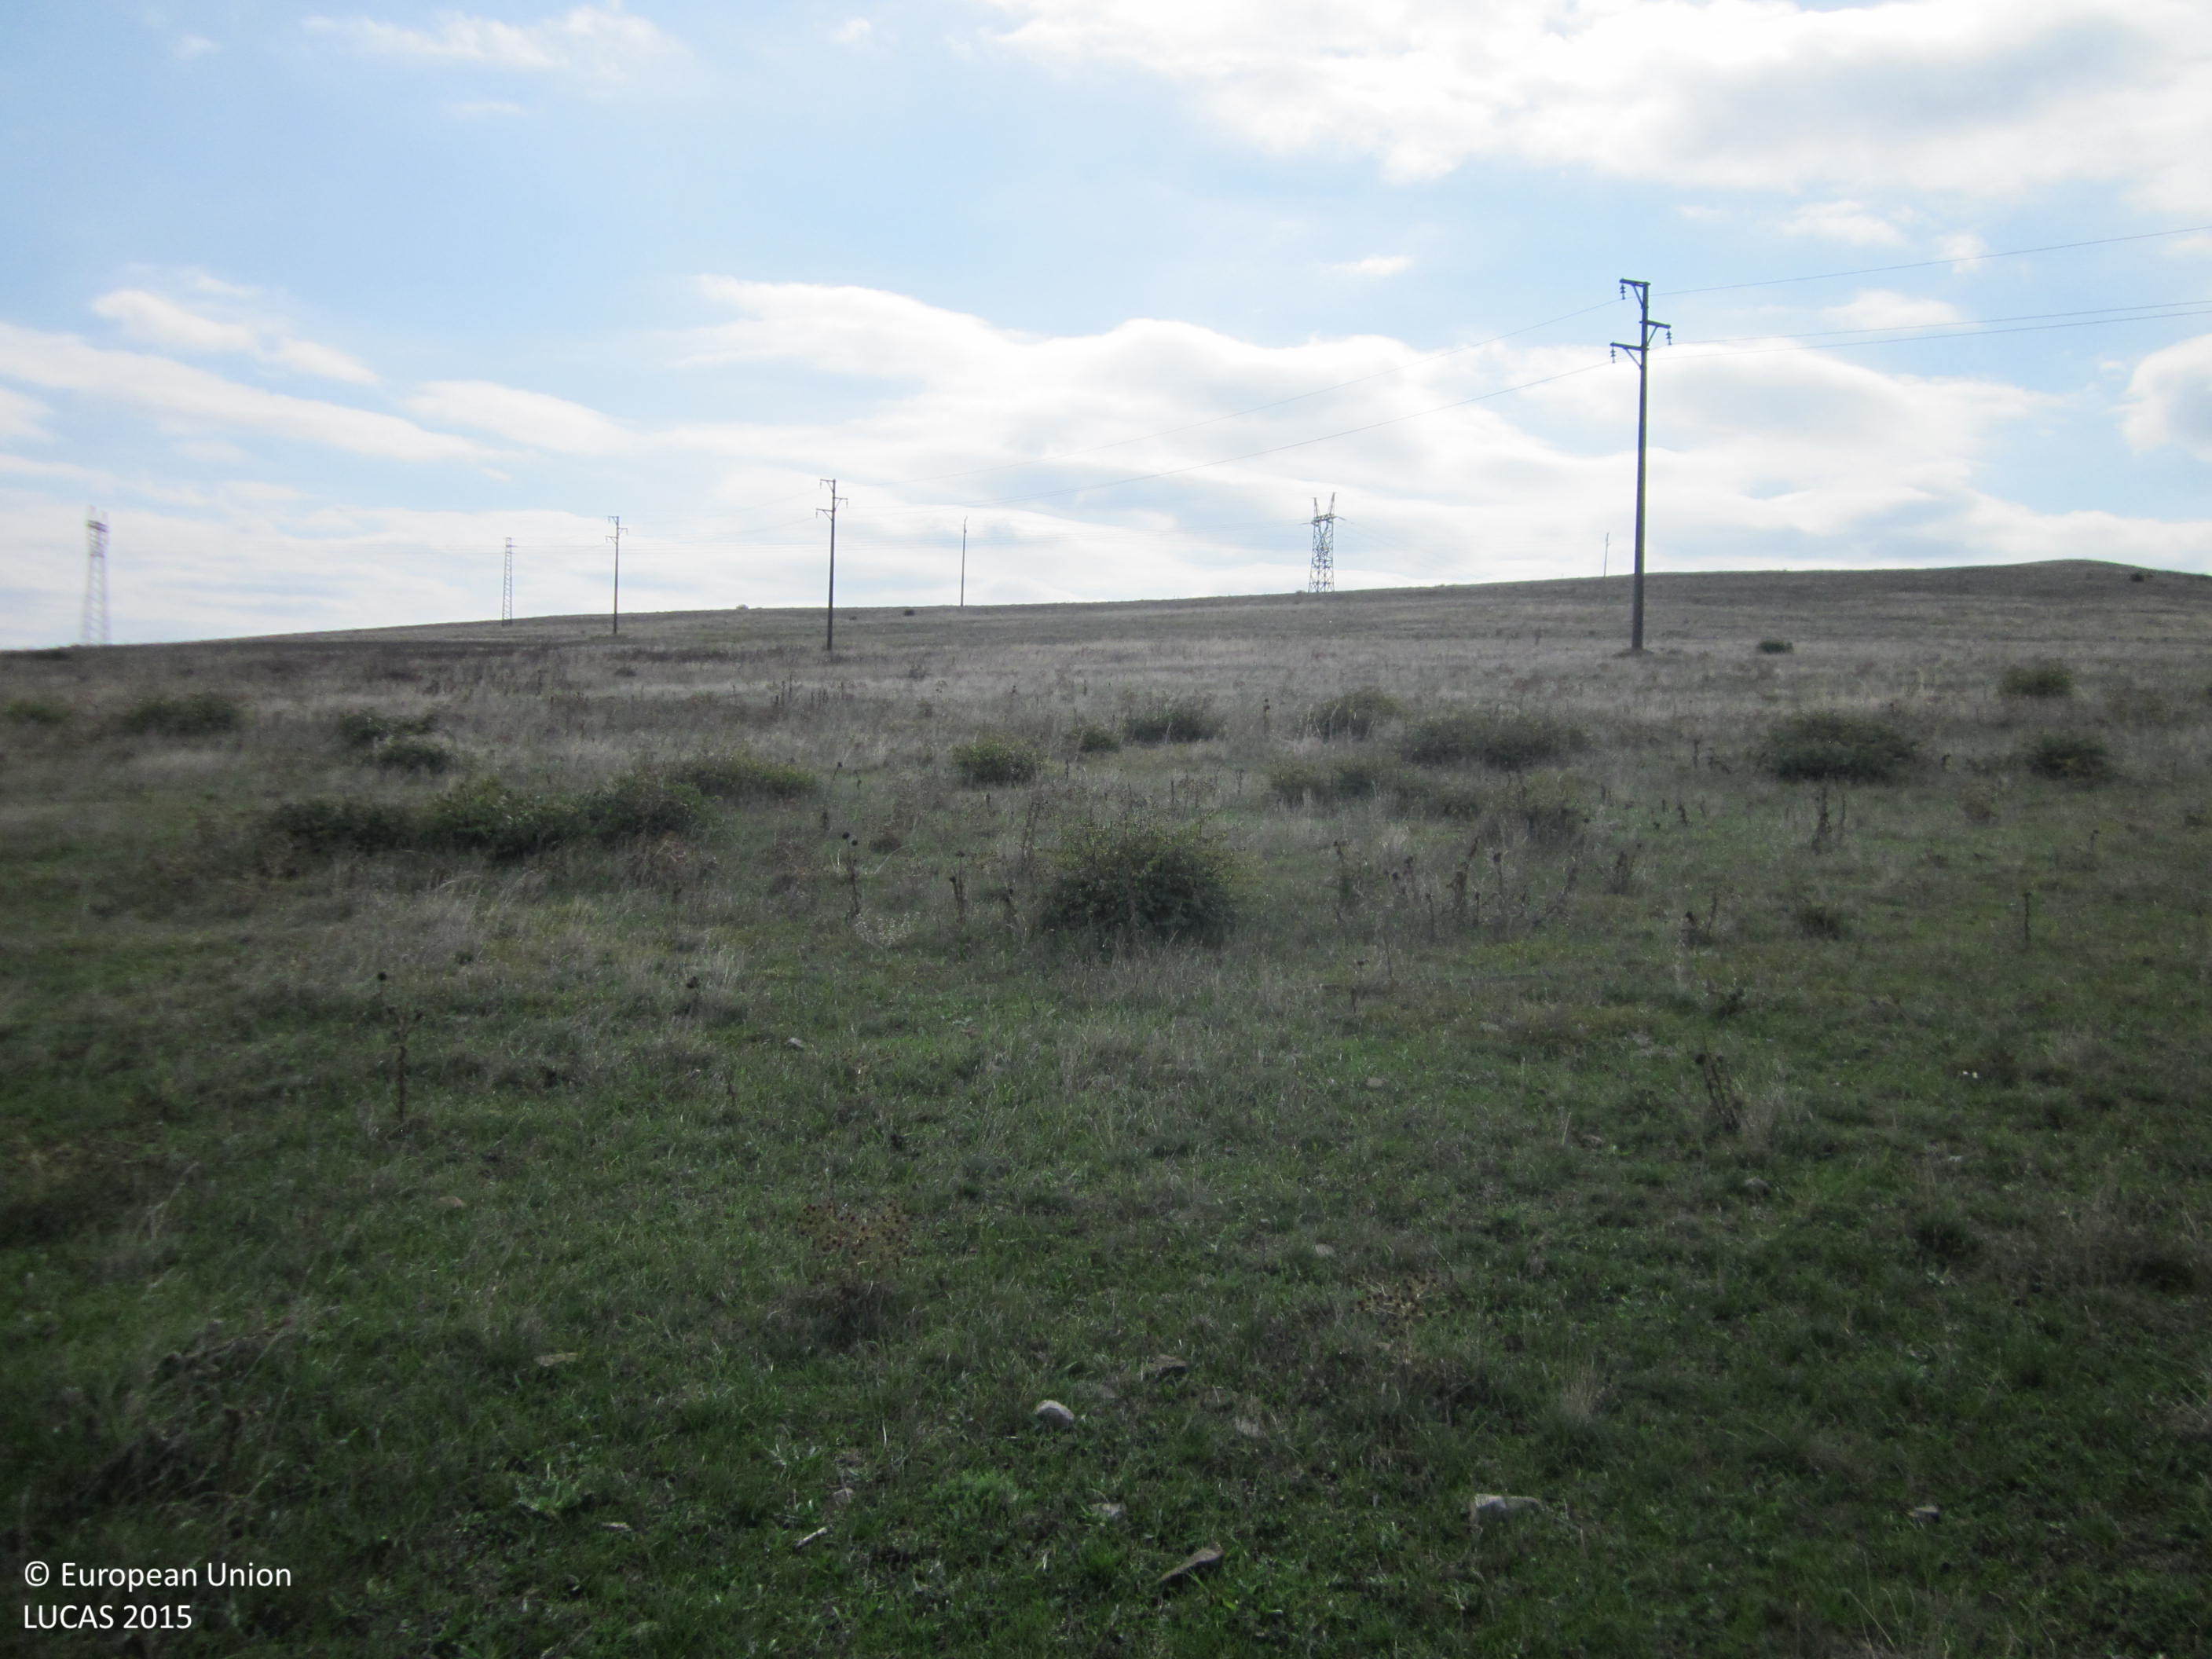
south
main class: Grassland
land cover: Grassland without tree/shrub cover
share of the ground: > 75 %
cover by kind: herbaceous plants 100 %
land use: Agriculture (excluding fallow land and kitchen gardens)
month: October
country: BG
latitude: 42.5951
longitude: 26.8345
